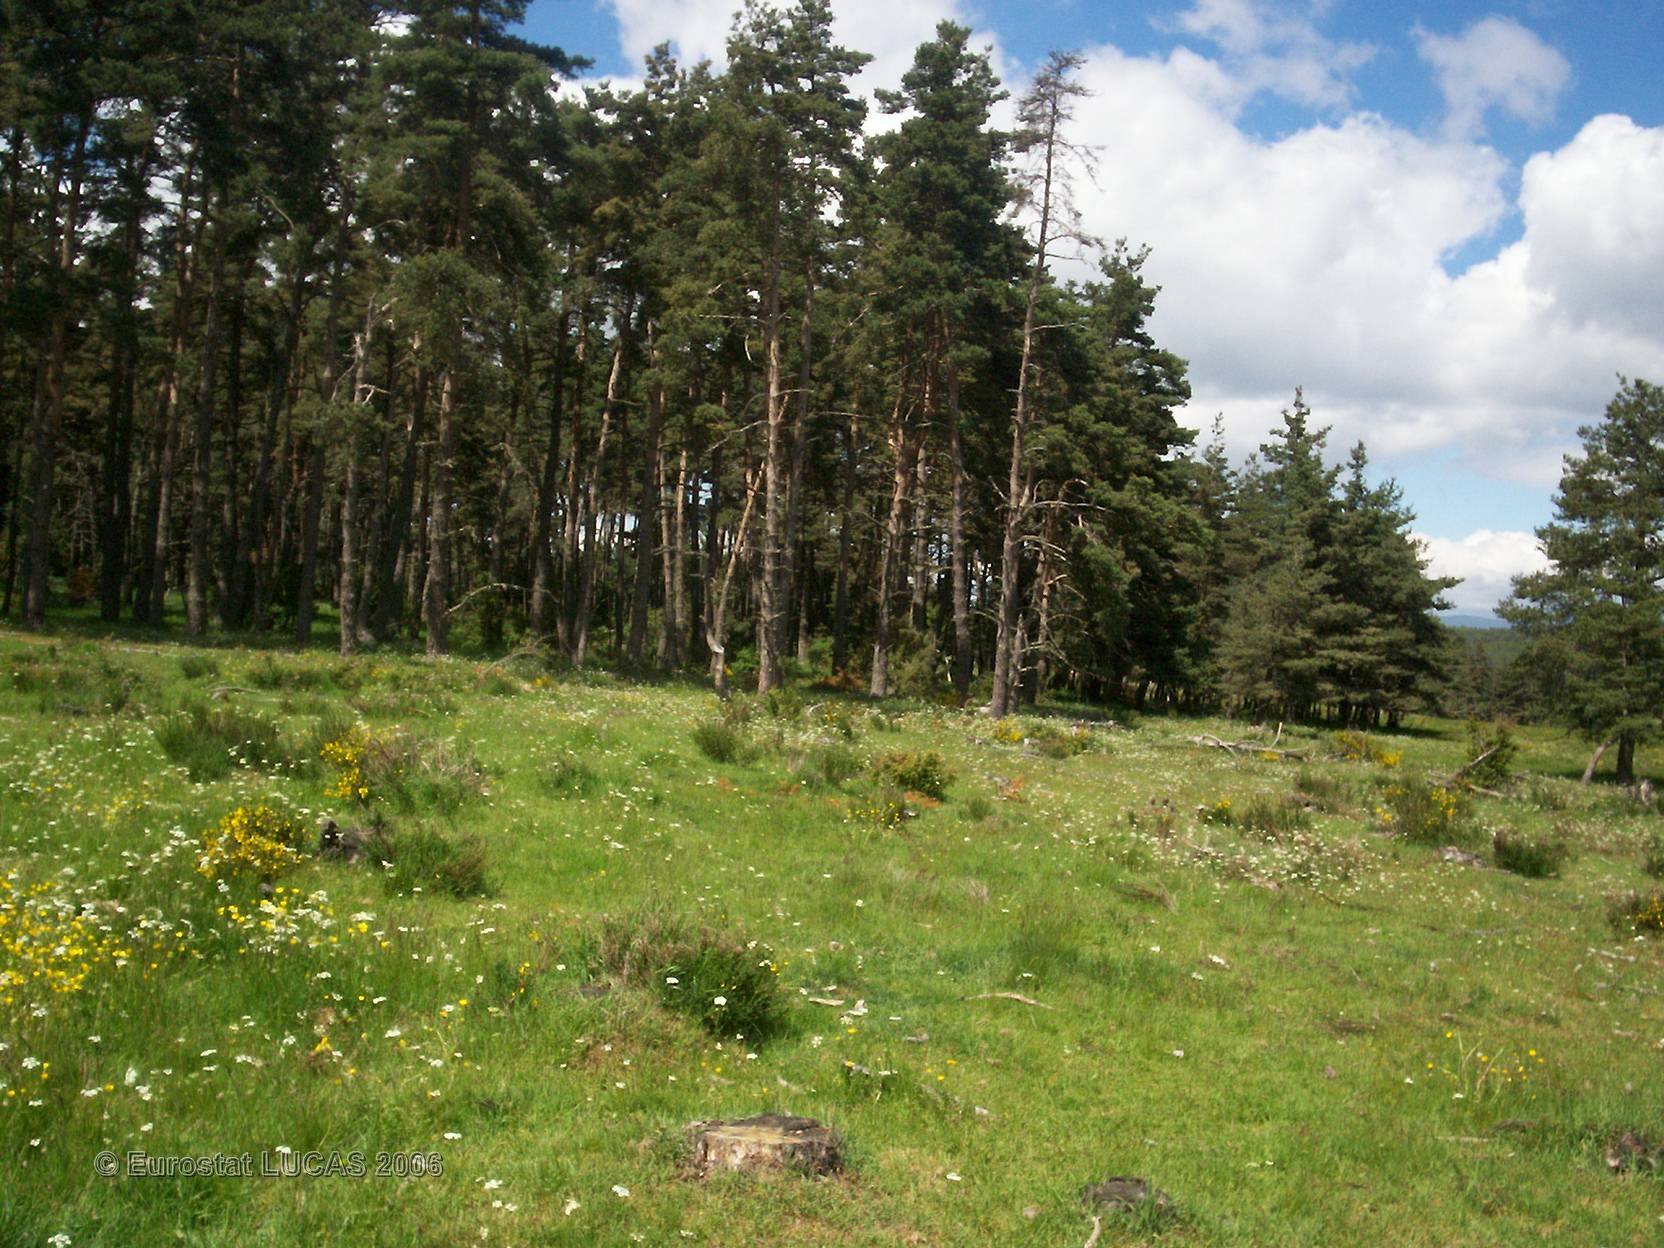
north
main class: Grassland
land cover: Grassland without tree/shrub cover
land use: Agriculture (excluding fallow land and kitchen gardens)
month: May
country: FR
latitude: 44.7667
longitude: 3.2948
